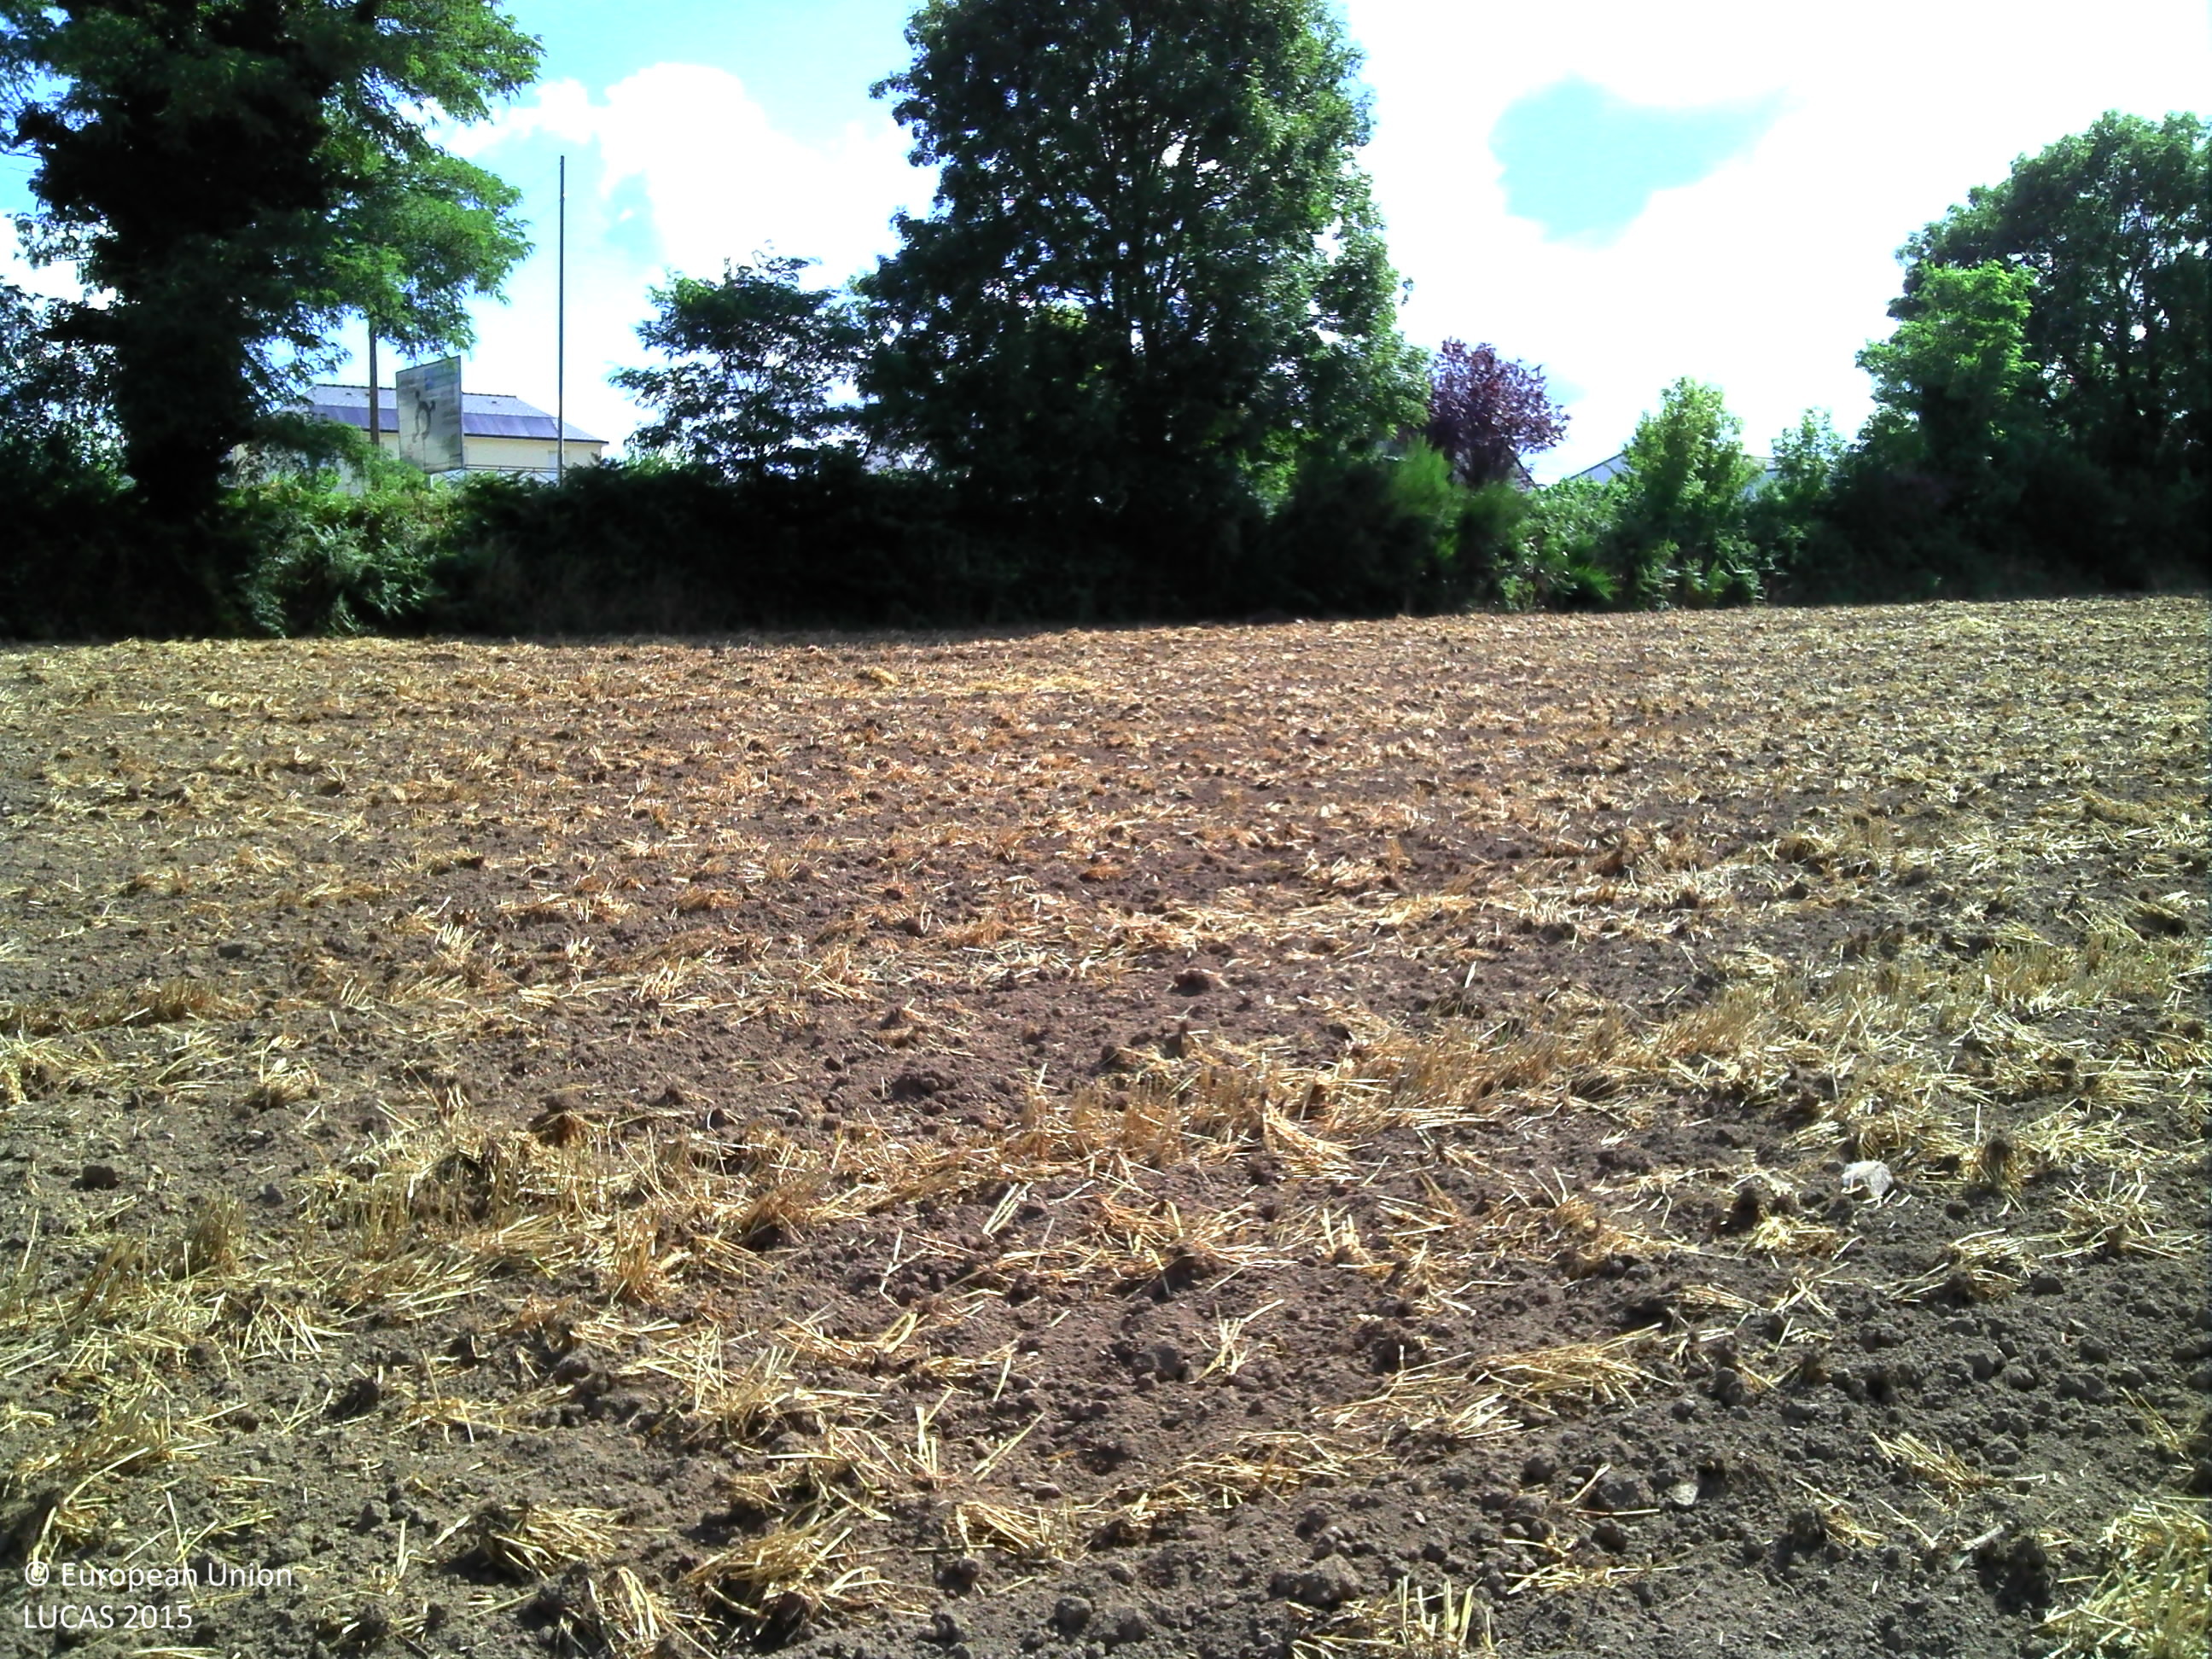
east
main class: Cropland
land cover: Barley
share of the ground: > 75 %
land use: Agriculture (excluding fallow land and kitchen gardens)
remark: Tilled/Sowed
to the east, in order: Barley; Lines of trees; Grass margins; Paved roads, cycling and walking lanes; Grass margins; Grassland without tree/shrub cover; Artificial constructions in urban areas
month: July
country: FR
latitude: 47.7911
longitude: -3.1920
